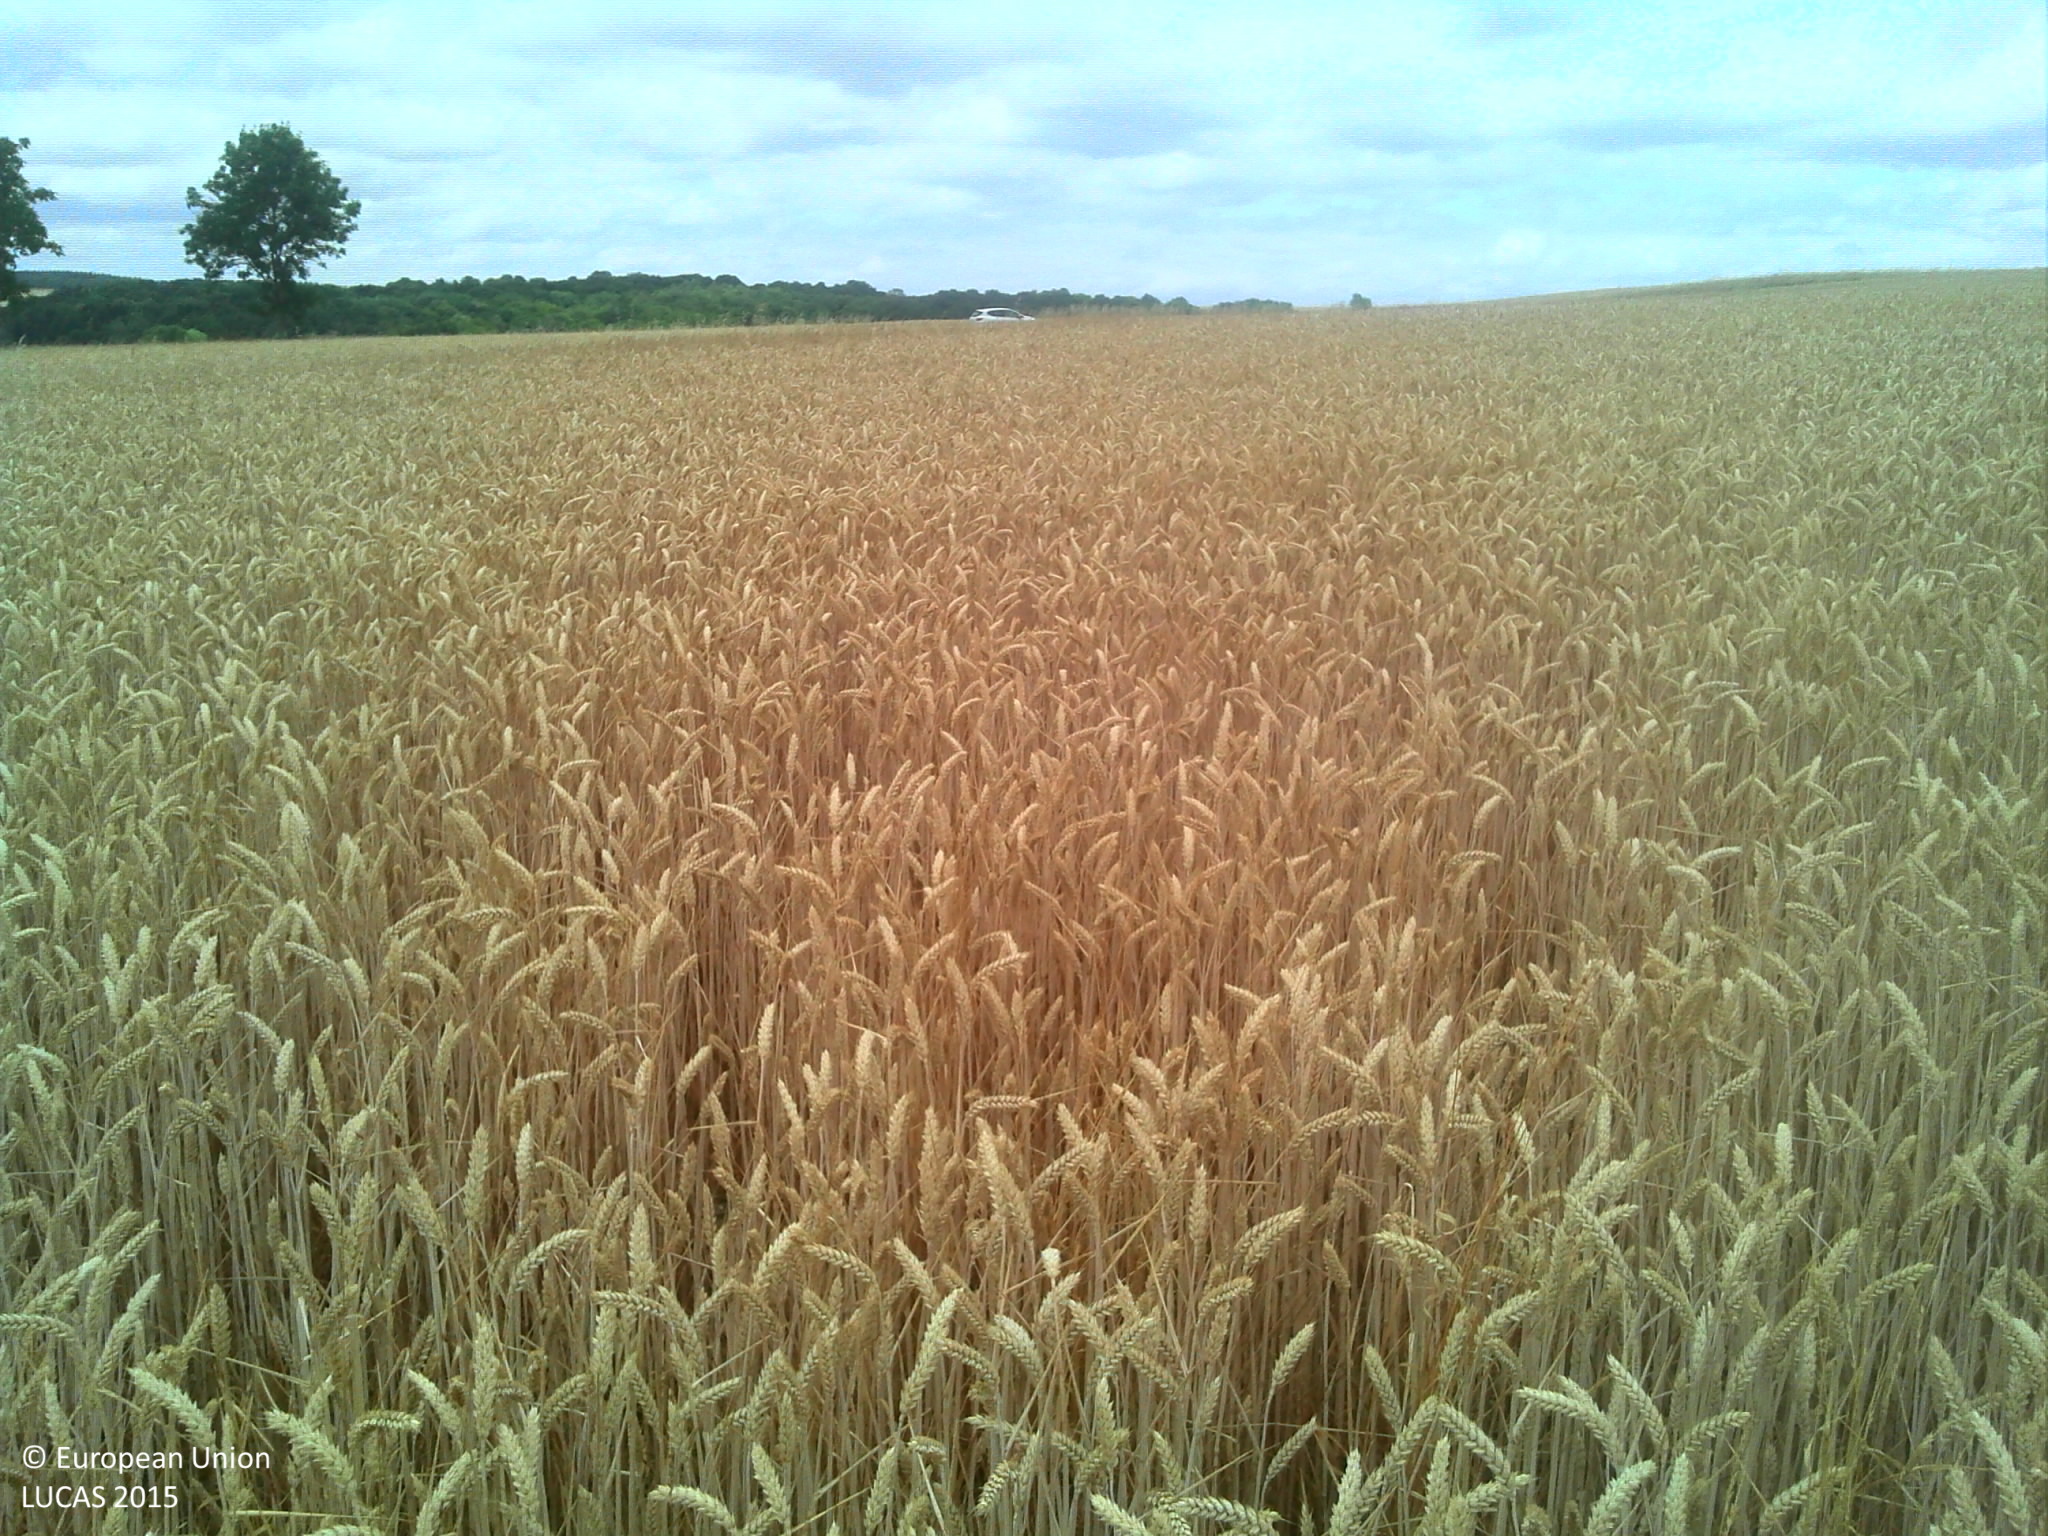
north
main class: Cropland
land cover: Common wheat
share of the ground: > 75 %
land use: Agriculture (excluding fallow land and kitchen gardens)
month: July
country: FR
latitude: 49.2311
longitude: 3.3320
